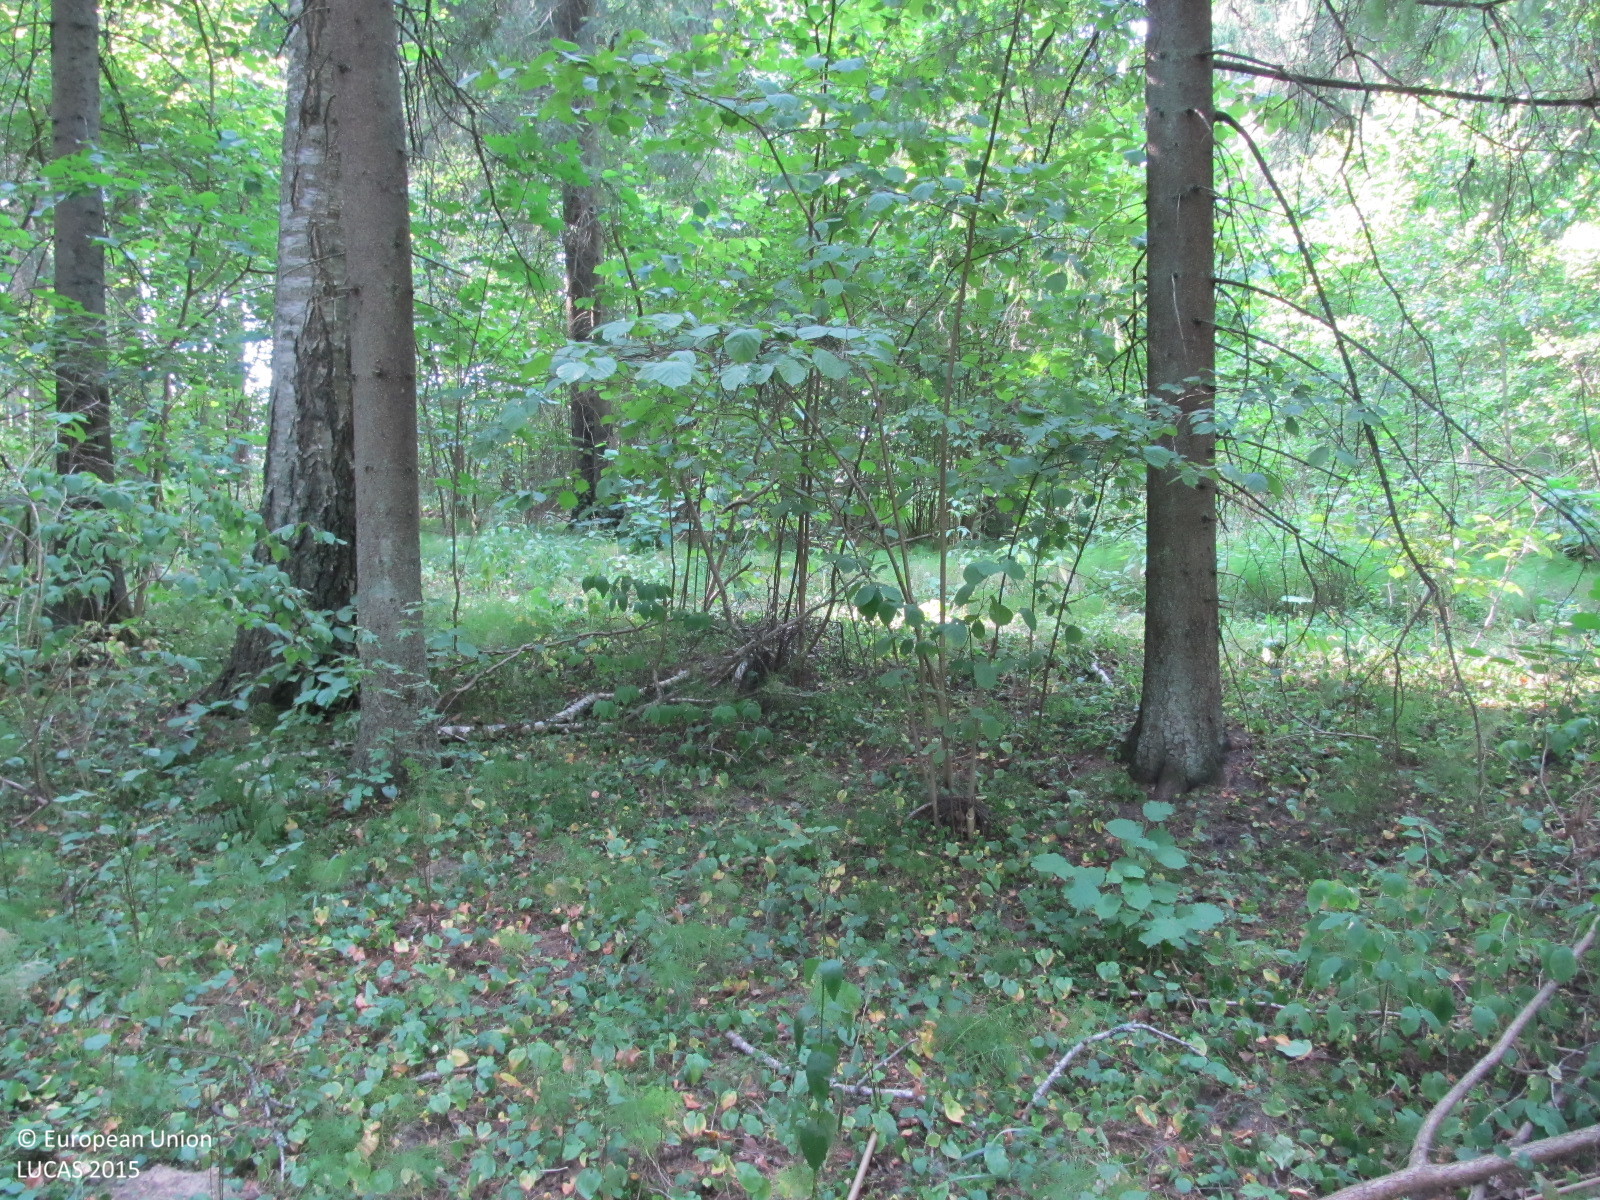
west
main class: Woodland
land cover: Spruce dominated mixed woodland
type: hemiboreal forest and nemoral coniferous forest and mixed broadleaved-coniferous forest
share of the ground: 50 - 75 %
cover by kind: coniferous forest trees 45 %, broadleaved forest trees 25 %, herbaceous plants 20 %, shrubs 10 %
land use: Forestry
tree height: > 5 m
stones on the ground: < 10 %
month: August
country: LT
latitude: 55.7574
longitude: 23.0243
